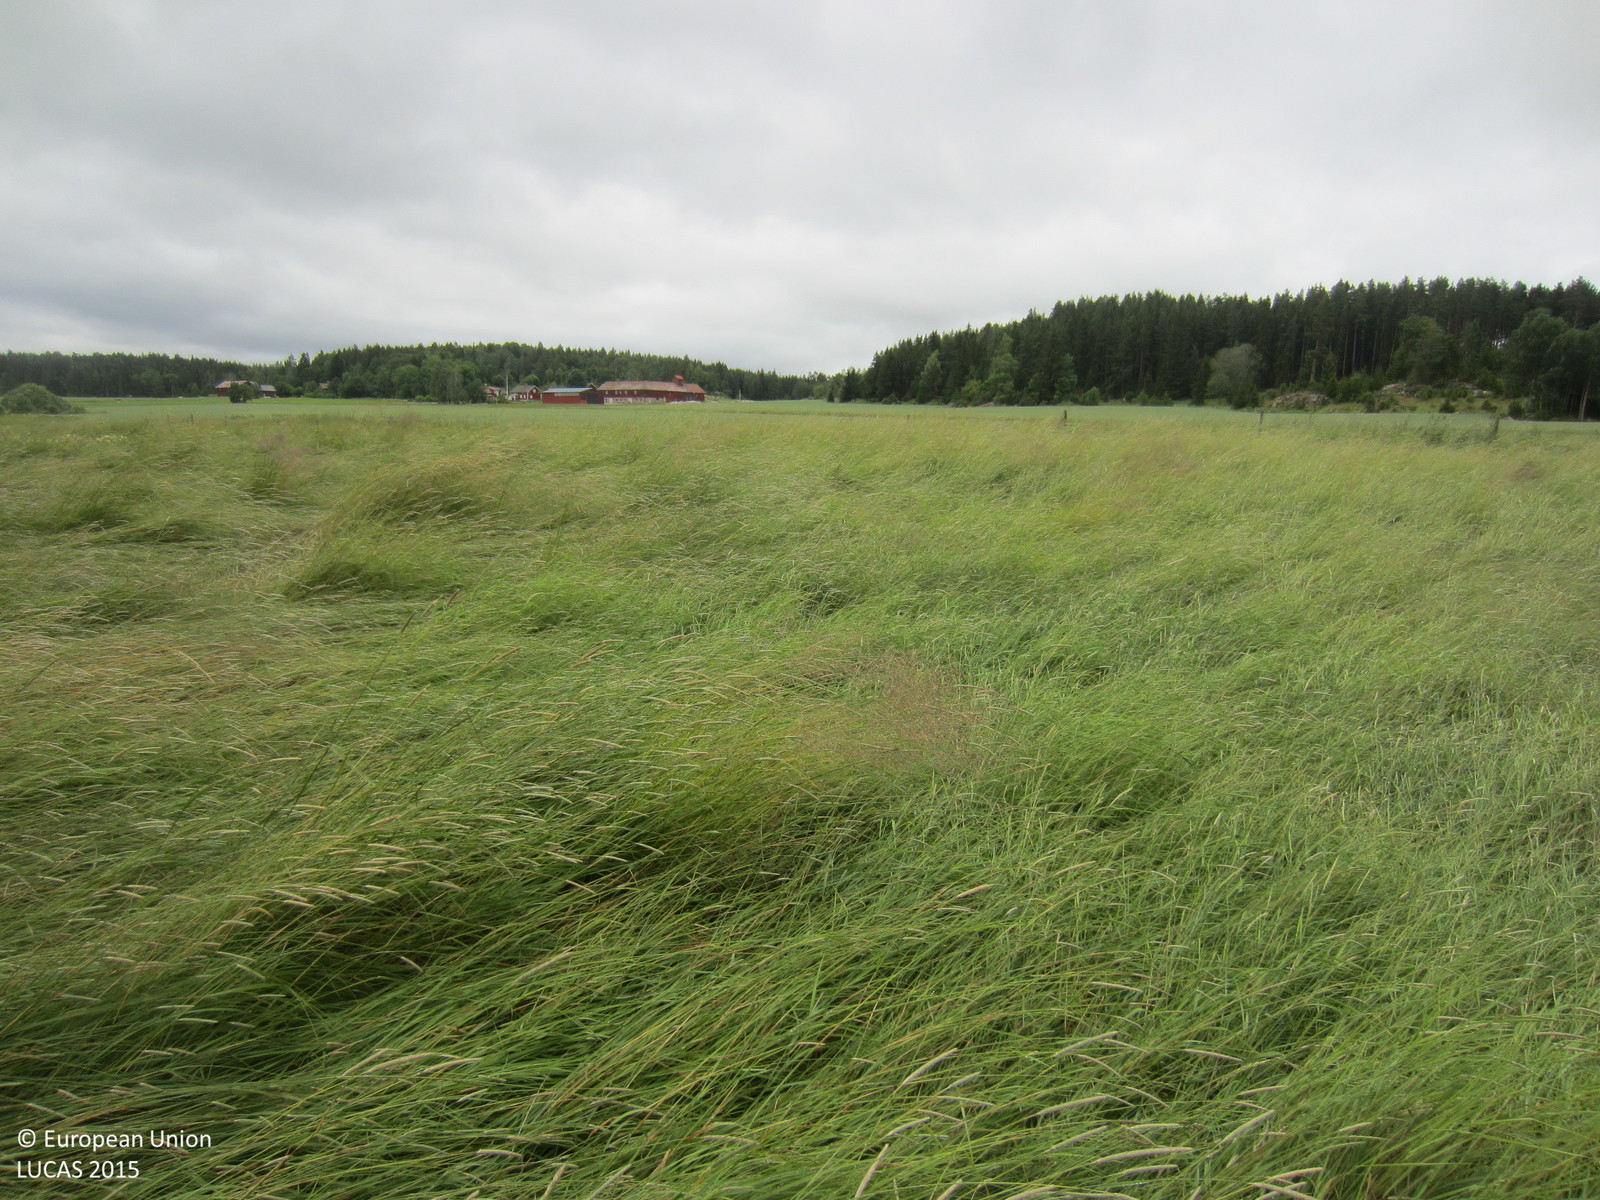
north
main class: Grassland
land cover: Grassland without tree/shrub cover
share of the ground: > 75 %
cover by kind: herbaceous plants 100 %
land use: Agriculture (excluding fallow land and kitchen gardens)
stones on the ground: > 50 %
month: July
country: SE
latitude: 59.7687
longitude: 17.0618
